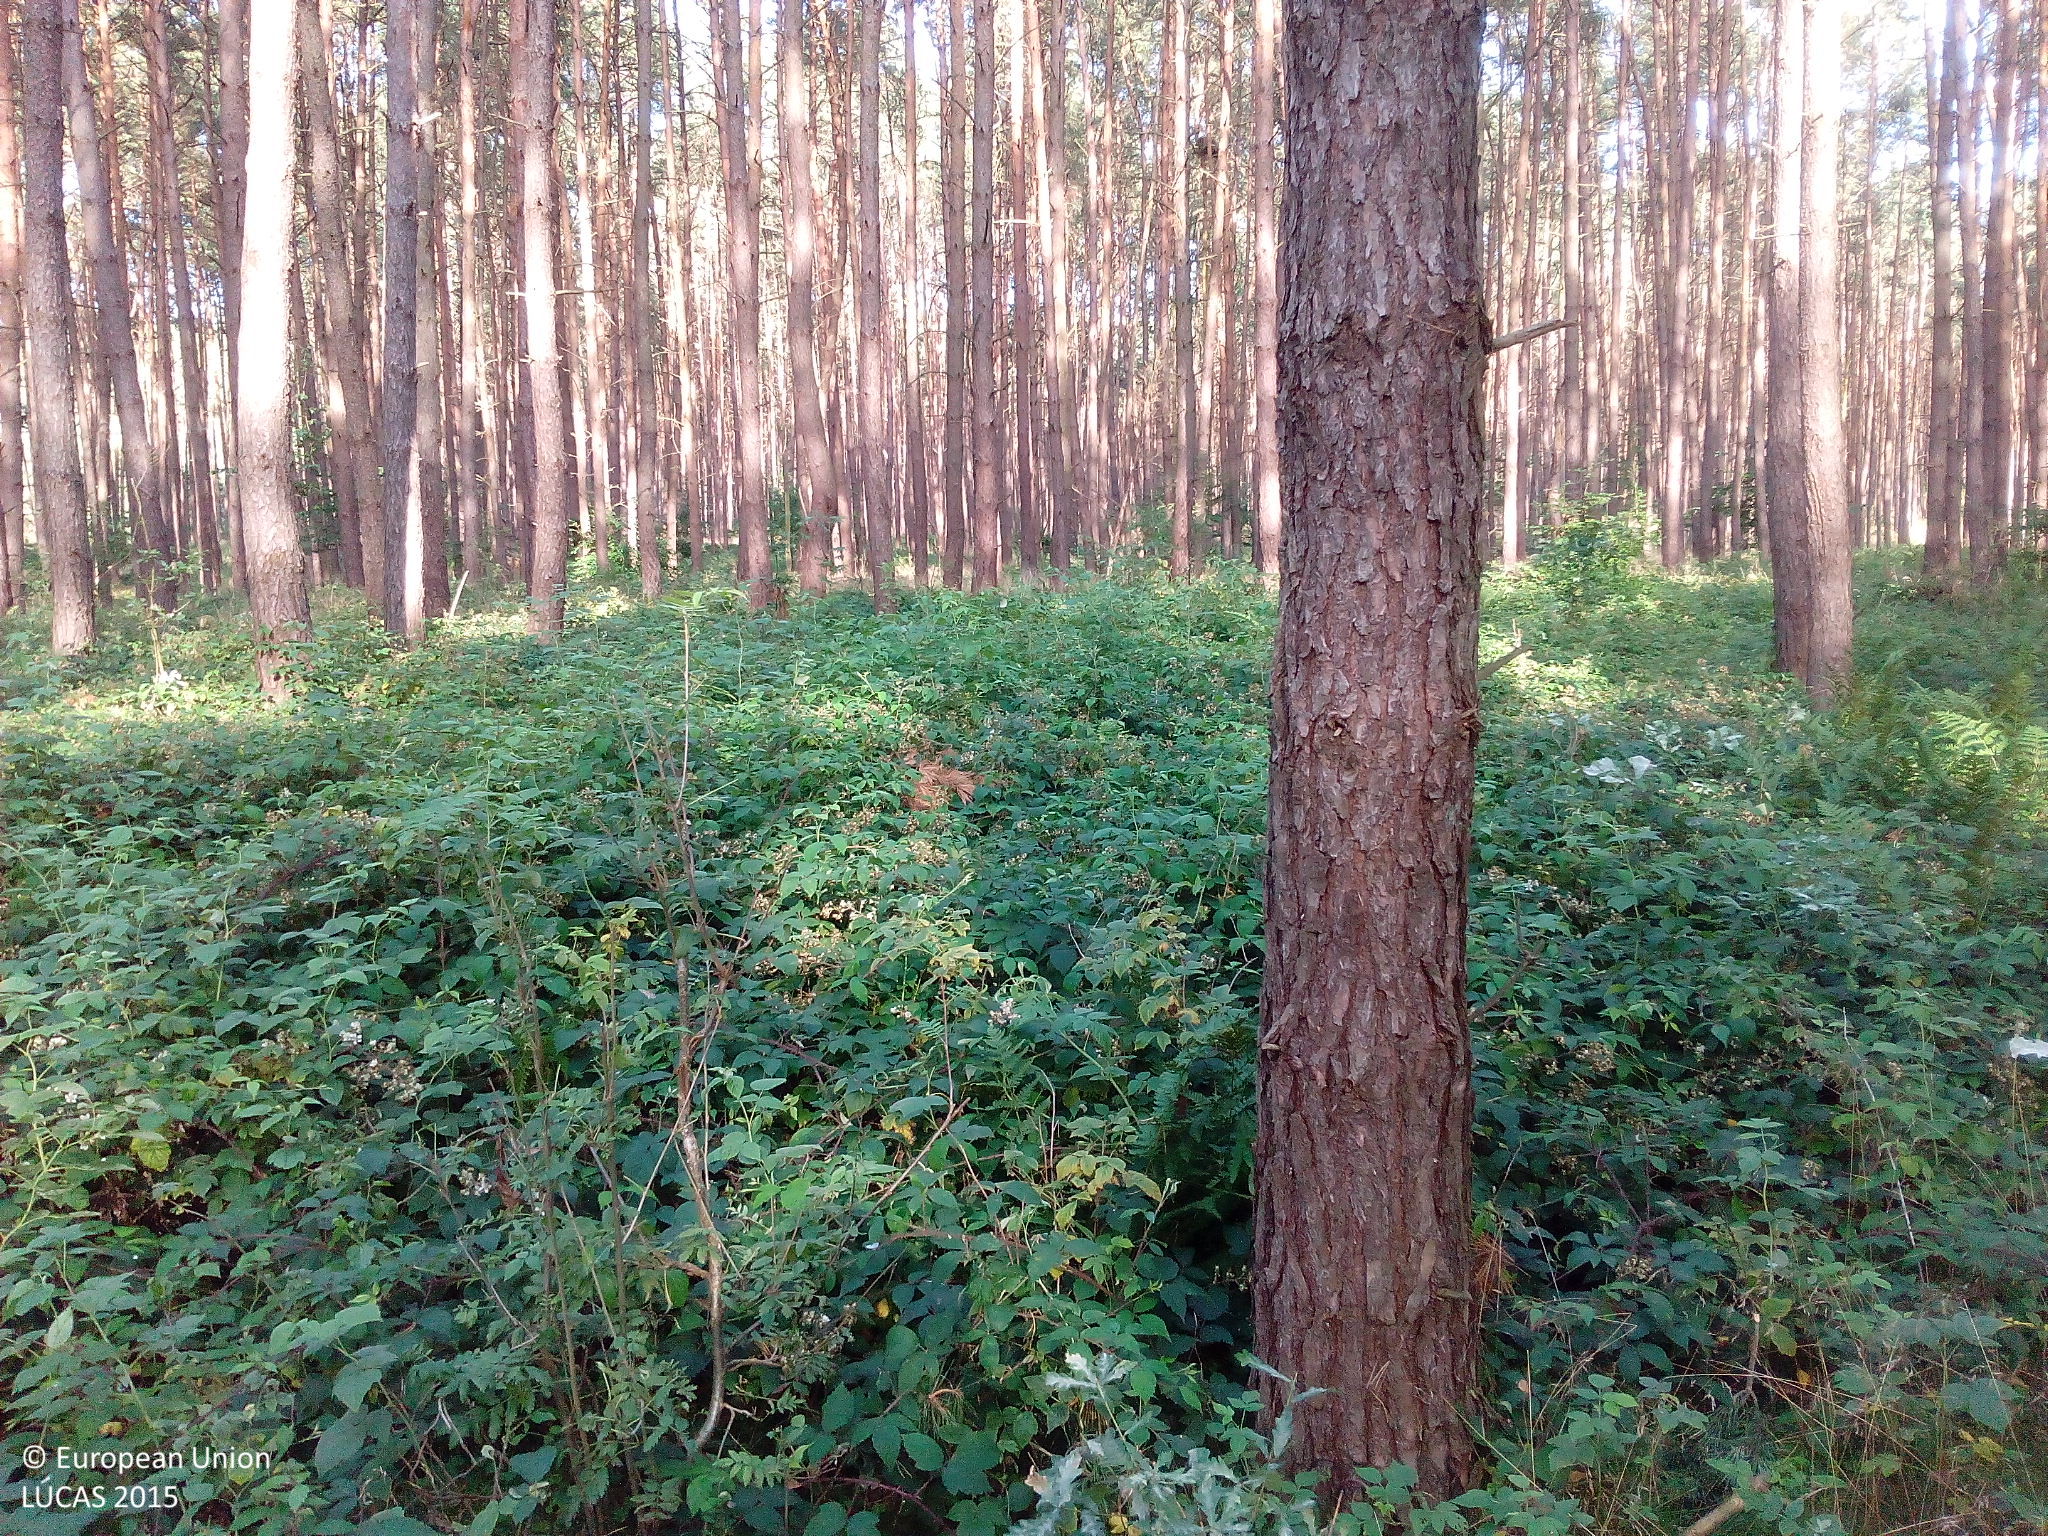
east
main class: Woodland
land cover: Pine dominated coniferous woodland
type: hemiboreal forest and nemoral coniferous forest and mixed broadleaved-coniferous forest
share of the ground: > 75 %
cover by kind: coniferous forest trees 80 %, shrubs 10 %, herbaceous plants 10 %
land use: Forestry
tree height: > 5 m
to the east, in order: Pine dominated coniferous woodland; Tracks; Pine dominated coniferous woodland
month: August
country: DE
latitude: 53.5388
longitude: 12.4588
